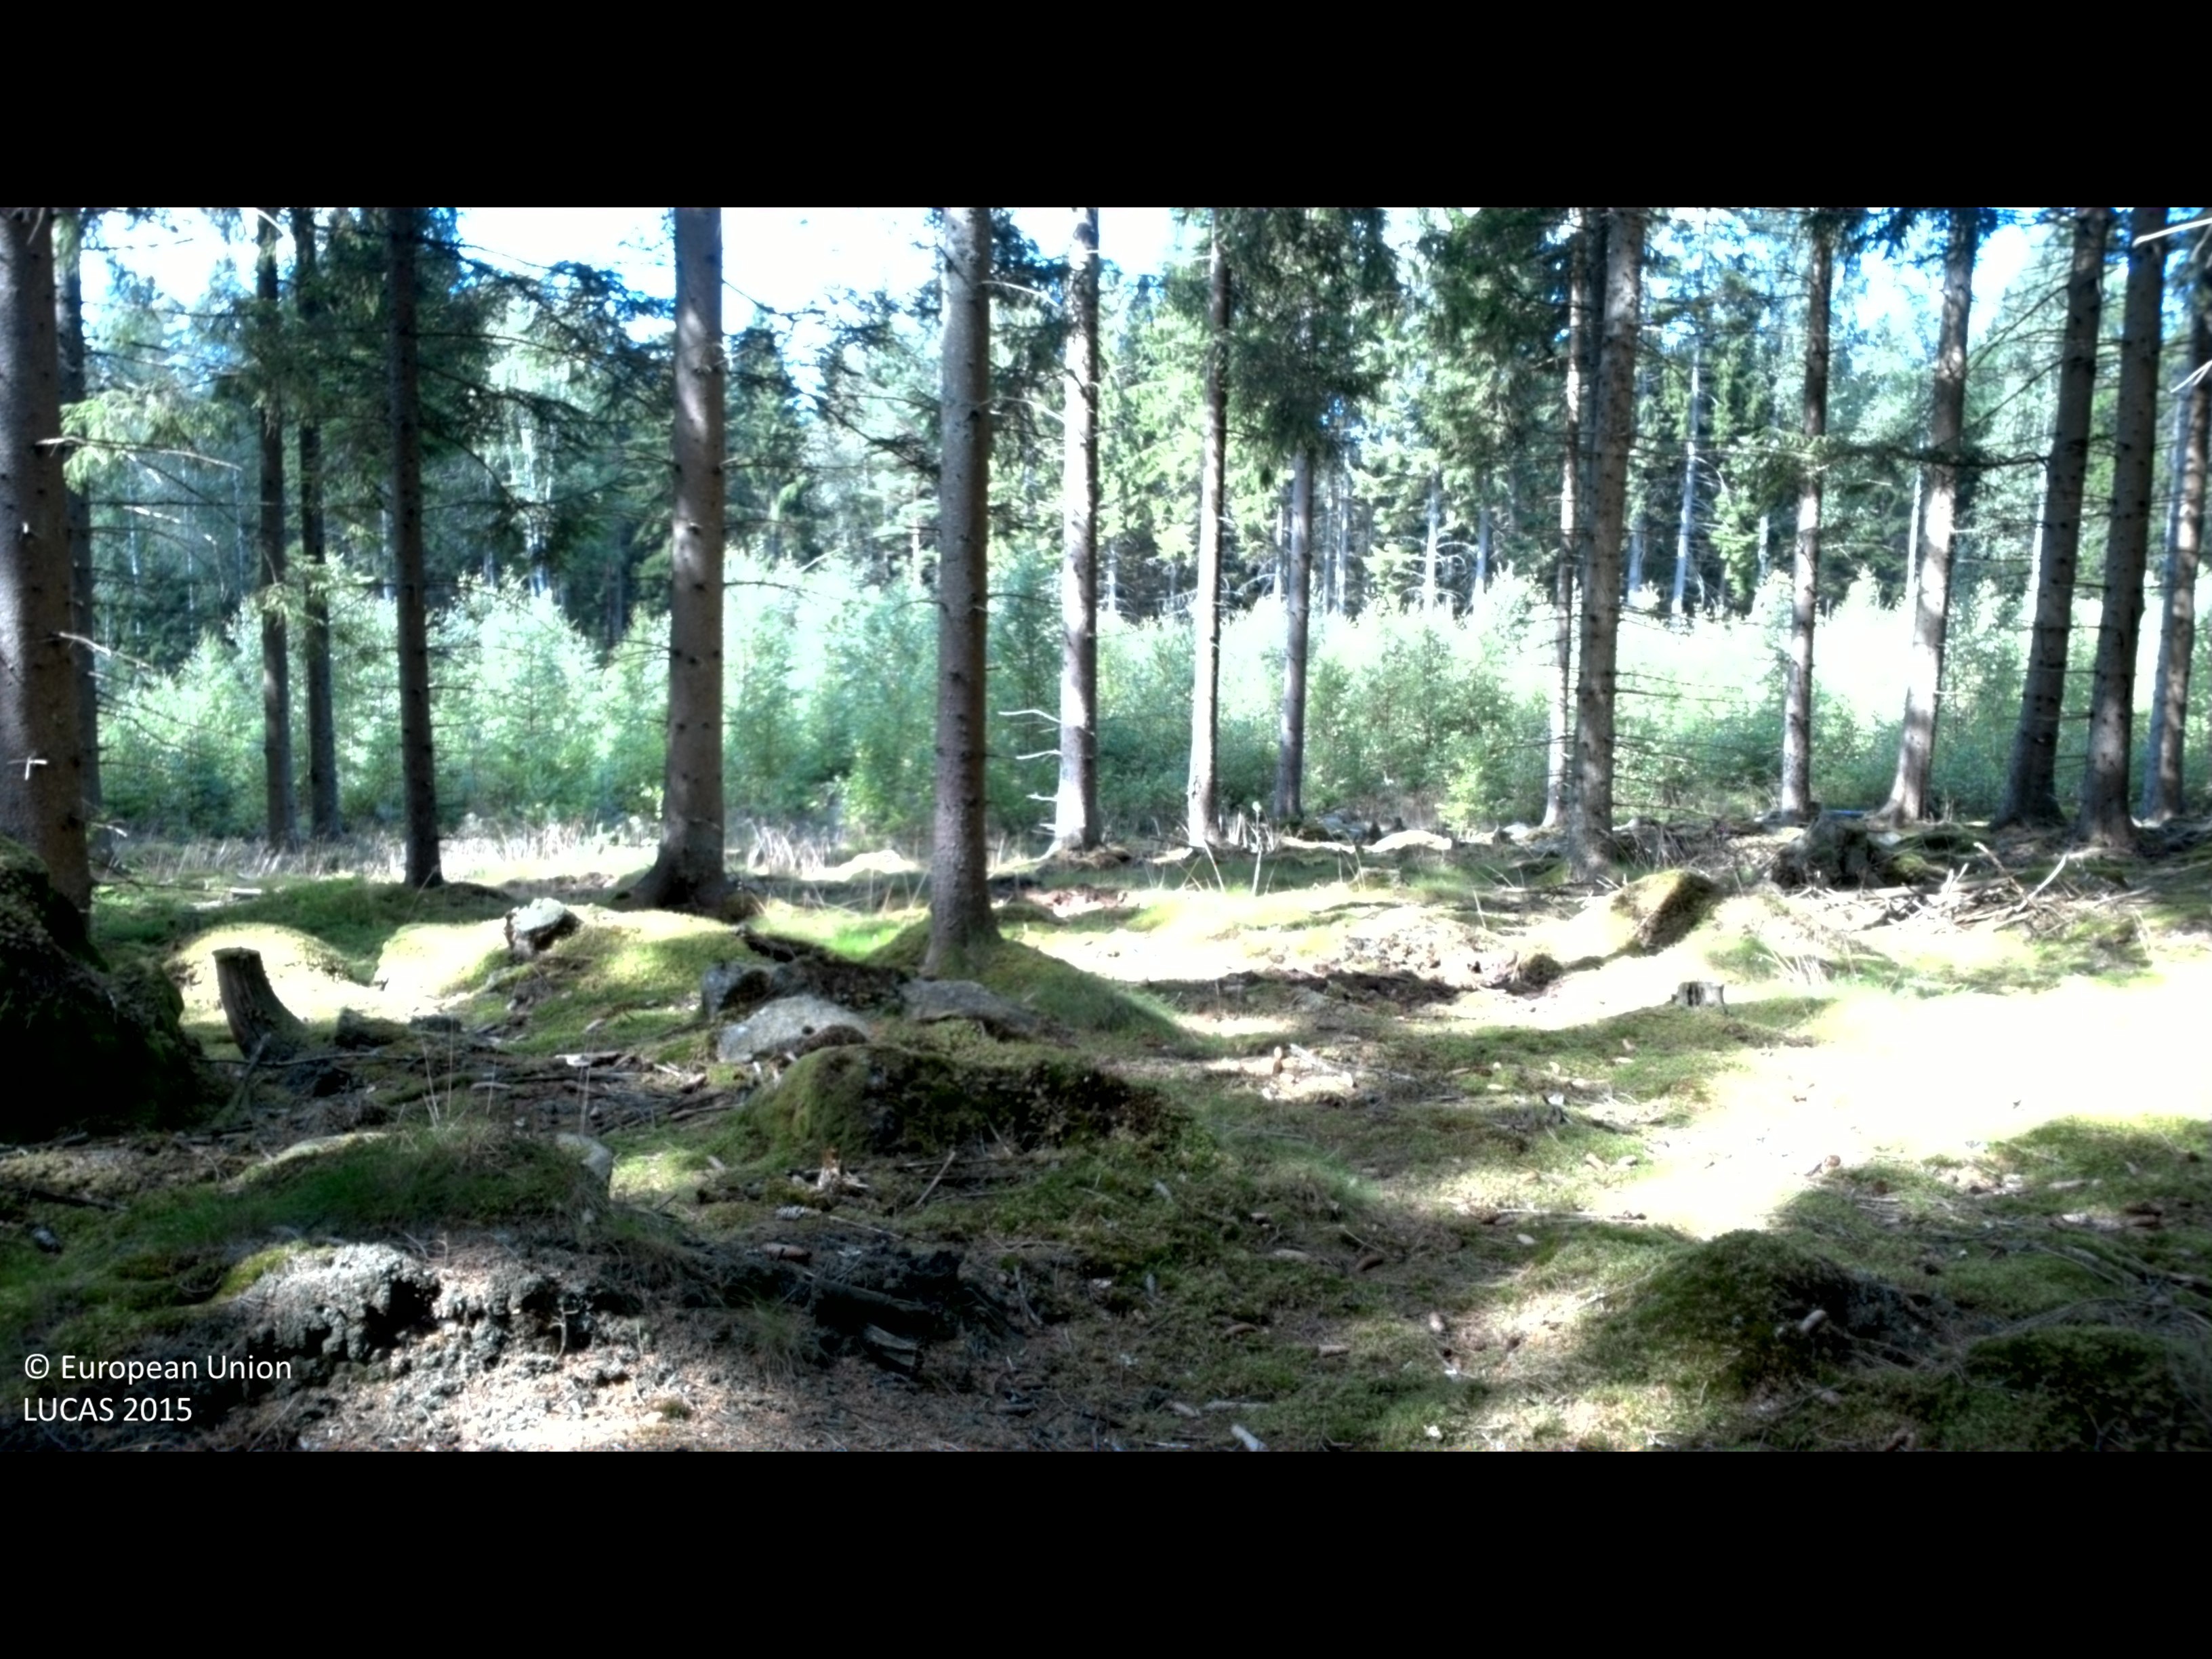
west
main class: Woodland
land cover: Spruce dominated coniferous woodland
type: boreal forest
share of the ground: 50 - 75 %
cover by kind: coniferous forest trees 70 %, lichens and mosses 25 %, herbaceous plants 5 %
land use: Forestry
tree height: > 5 m
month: August
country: SE
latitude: 56.3704
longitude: 14.7417
